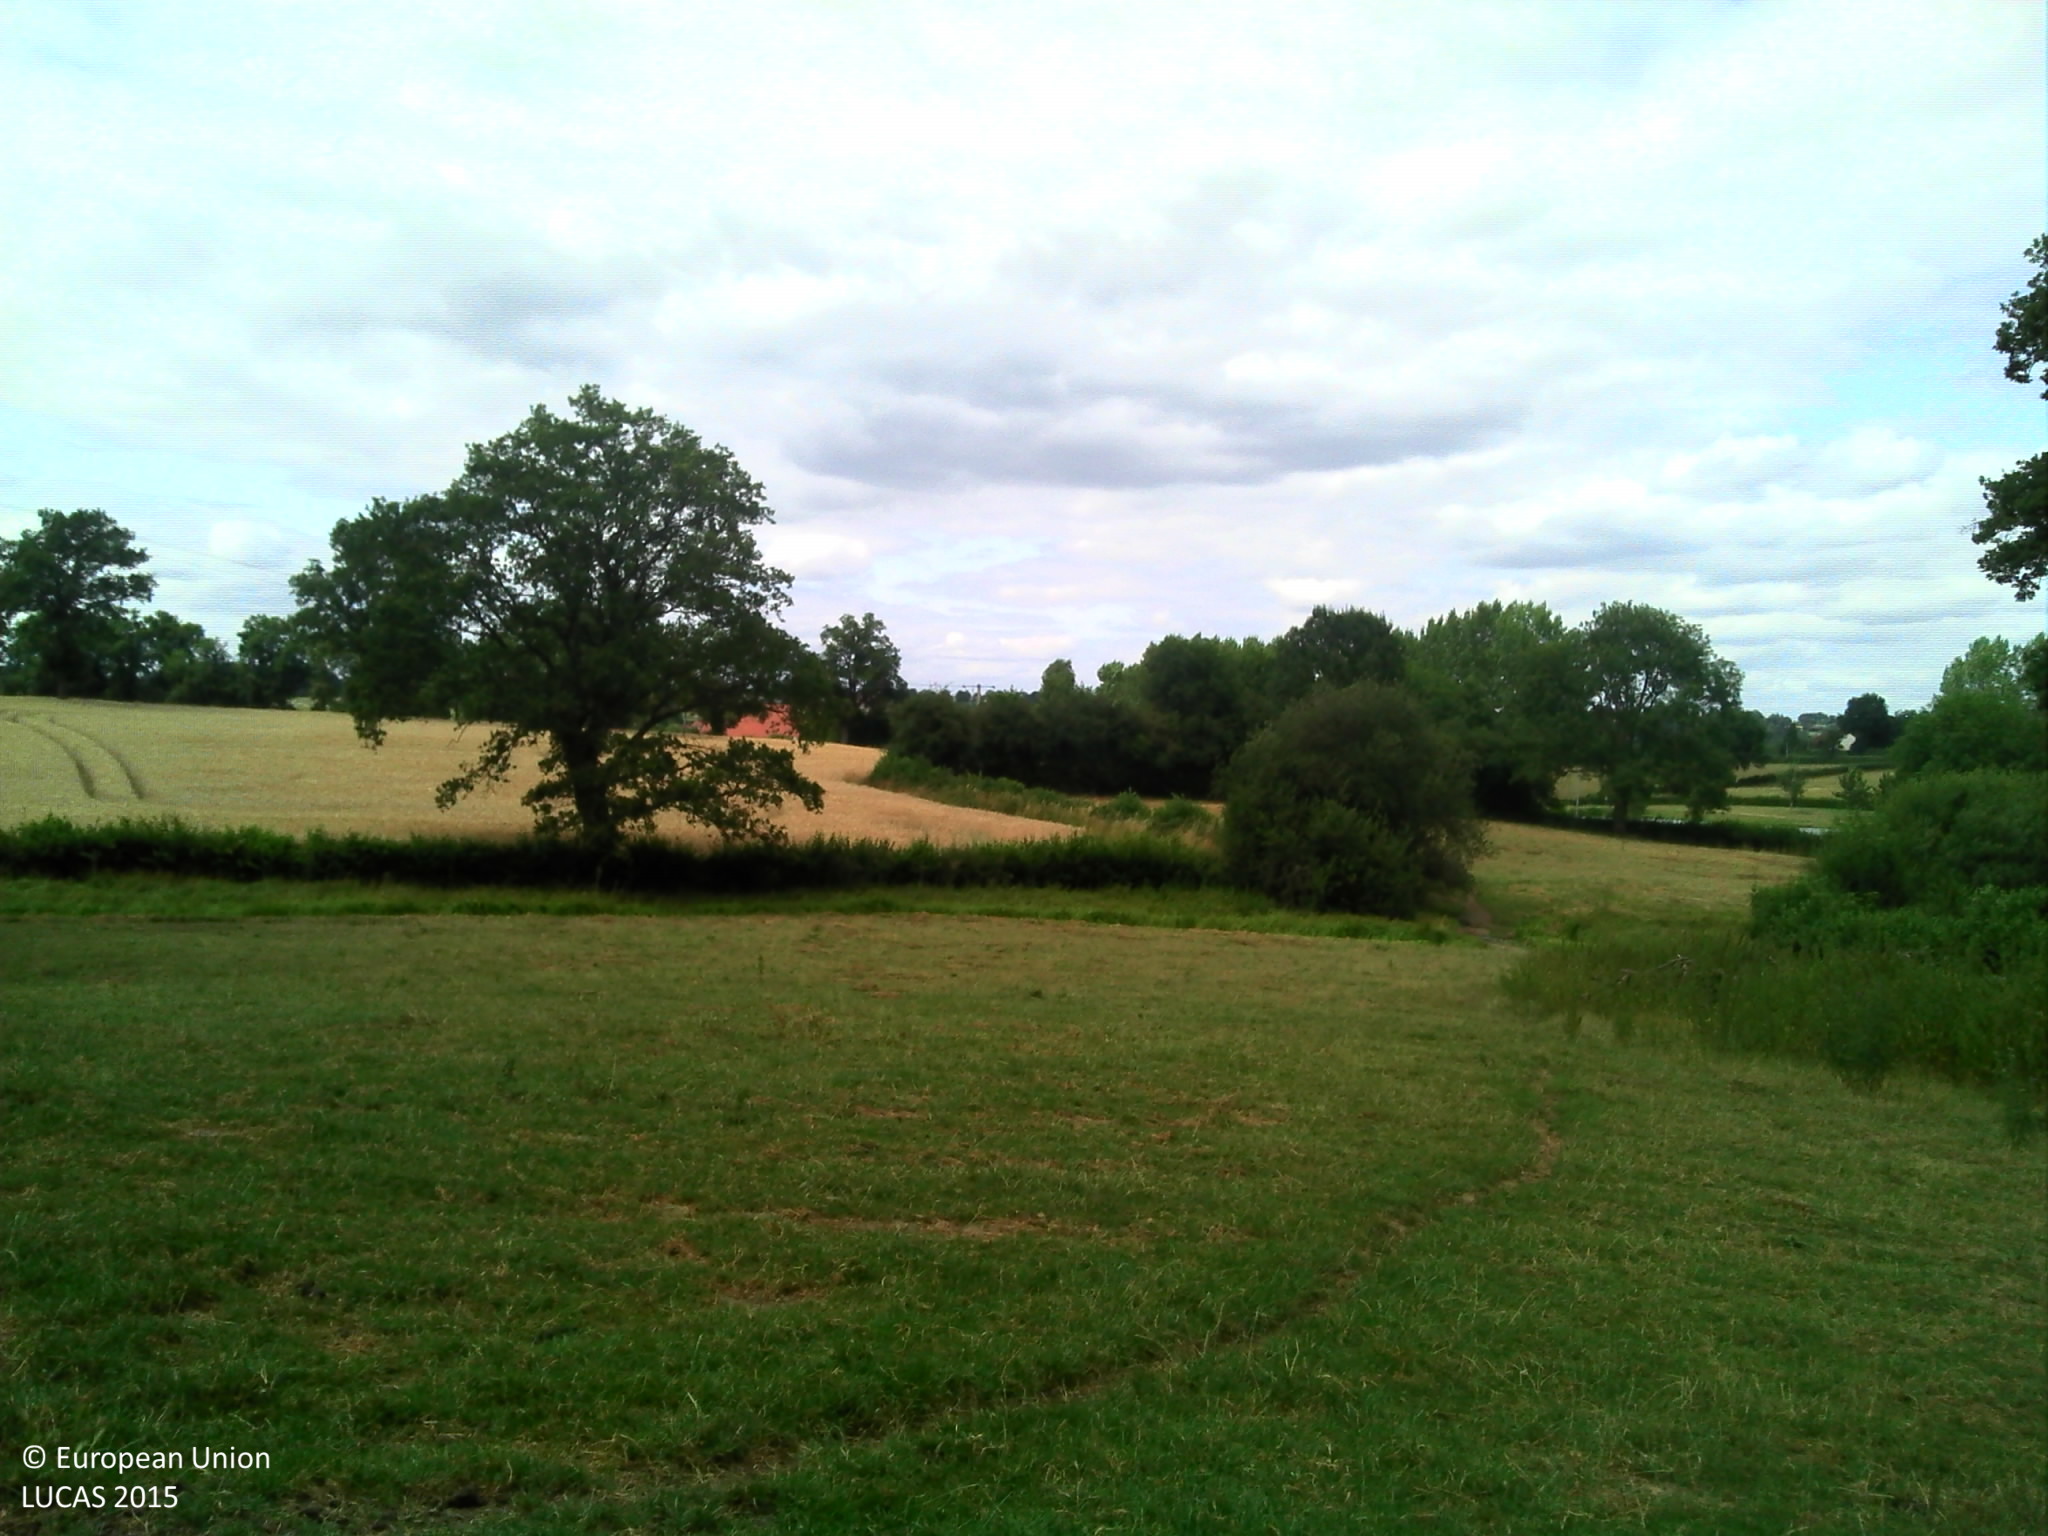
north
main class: Grassland
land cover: Grassland without tree/shrub cover
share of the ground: > 75 %
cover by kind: herbaceous plants 95 %, shrubs 5 %
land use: Agriculture (excluding fallow land and kitchen gardens)
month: July
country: FR
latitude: 46.4117
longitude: 3.0115
